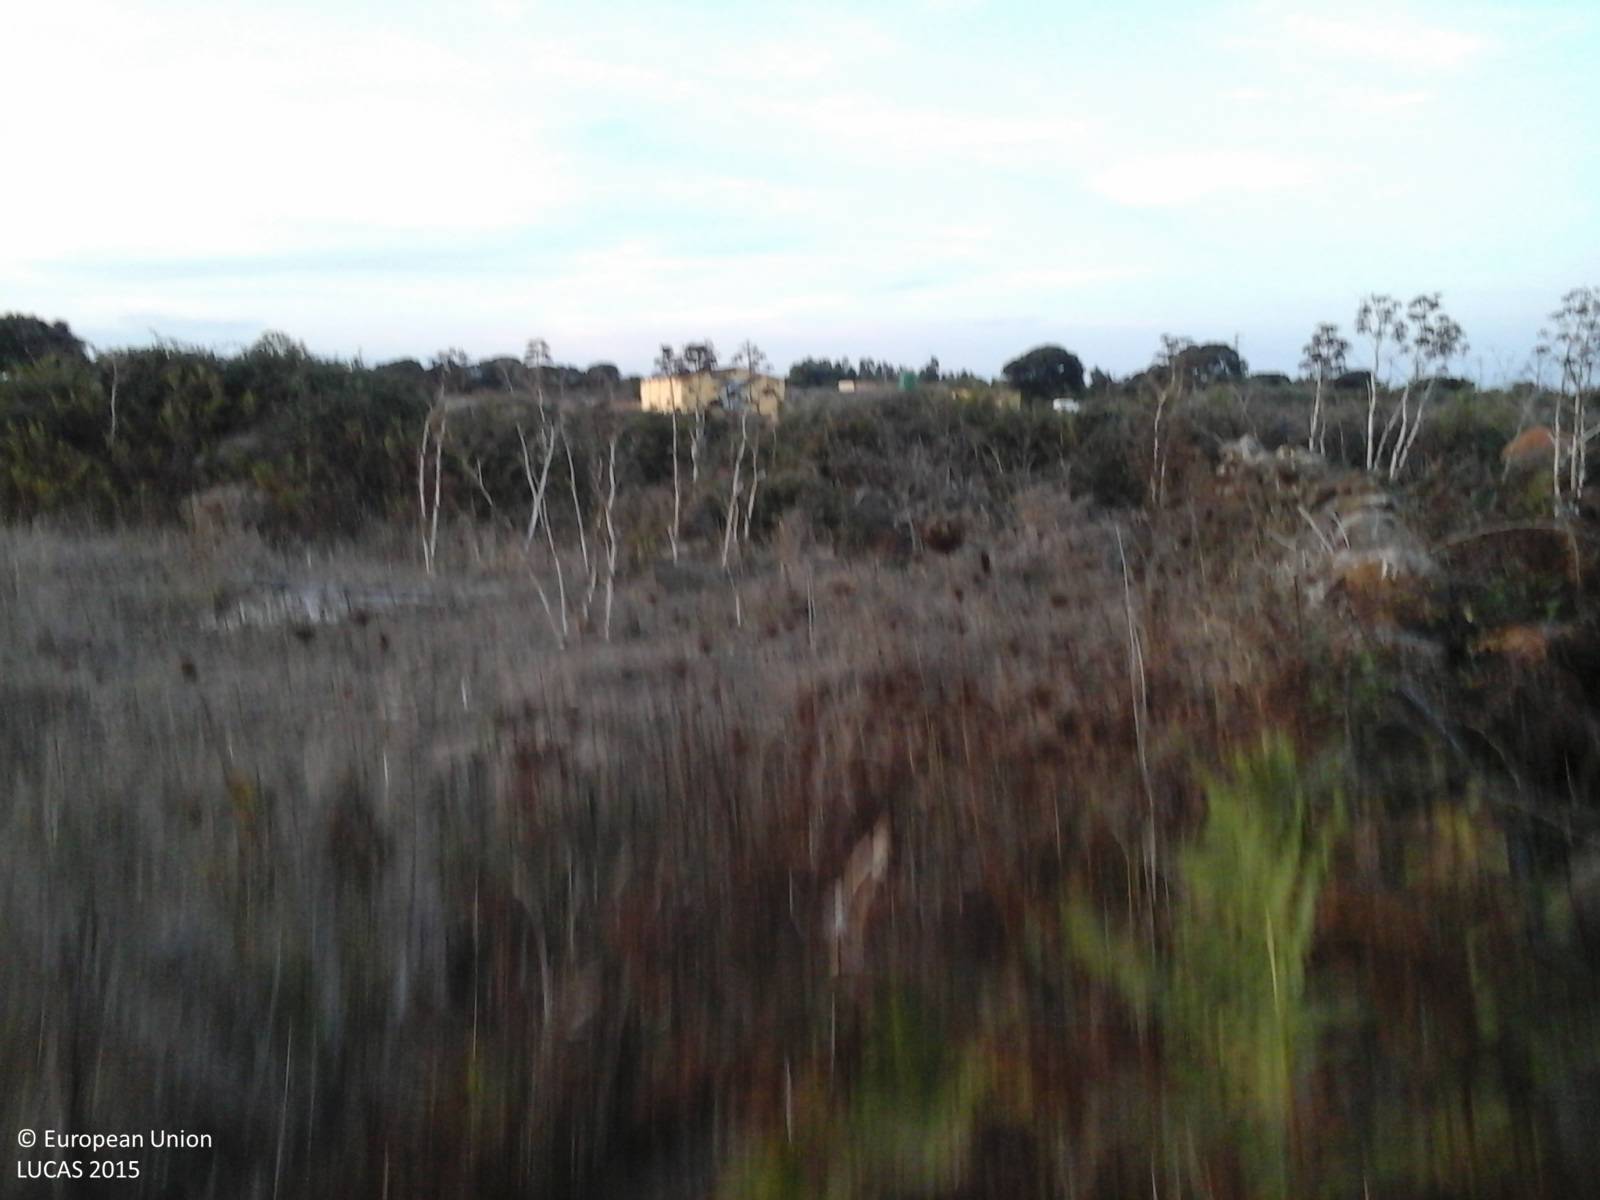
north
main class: Grassland
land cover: Spontaneously vegetated surfaces
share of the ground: > 75 %
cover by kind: herbaceous plants 100 %
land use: Agriculture (excluding fallow land and kitchen gardens)
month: October
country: IT
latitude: 40.2752
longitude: 8.5843
